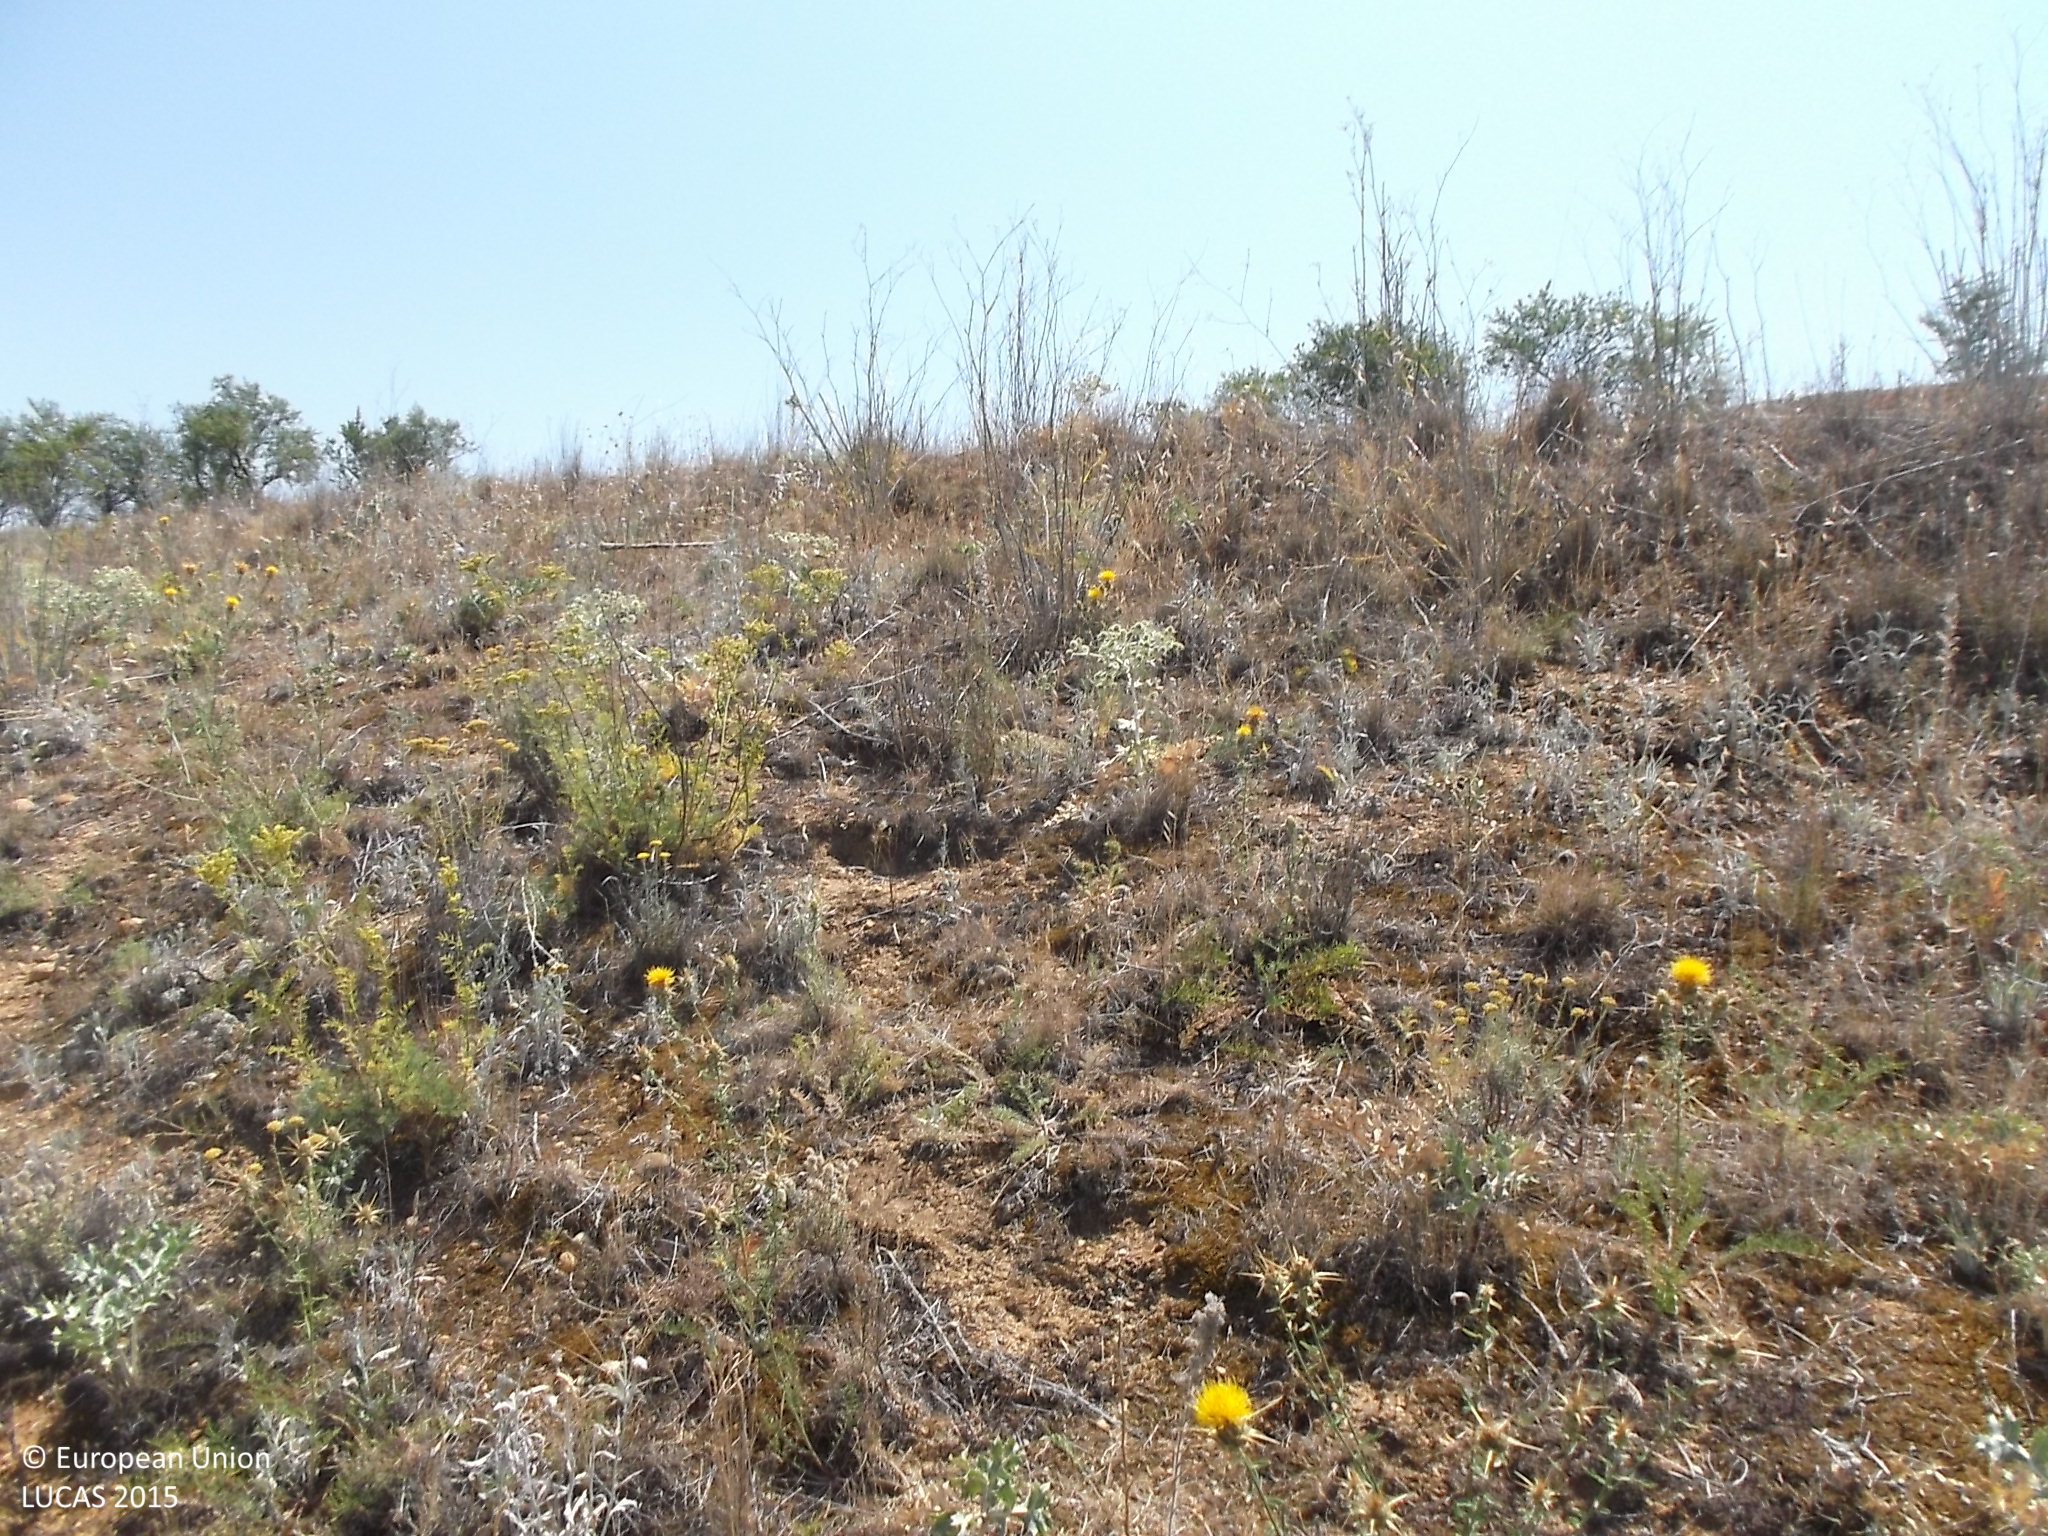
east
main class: Grassland
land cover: Grassland without tree/shrub cover
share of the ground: > 75 %
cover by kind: herbaceous plants 100 %
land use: Semi-natural and natural areas not in use
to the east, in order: Grassland without tree/shrub cover; Lines of trees; Tracks; Lines of trees; Artificial constructions in urban areas; Grassland with sparse tree/shrub cover; Grassland without tree/shrub cover
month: July
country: ES
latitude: 41.5221
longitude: -5.4069
